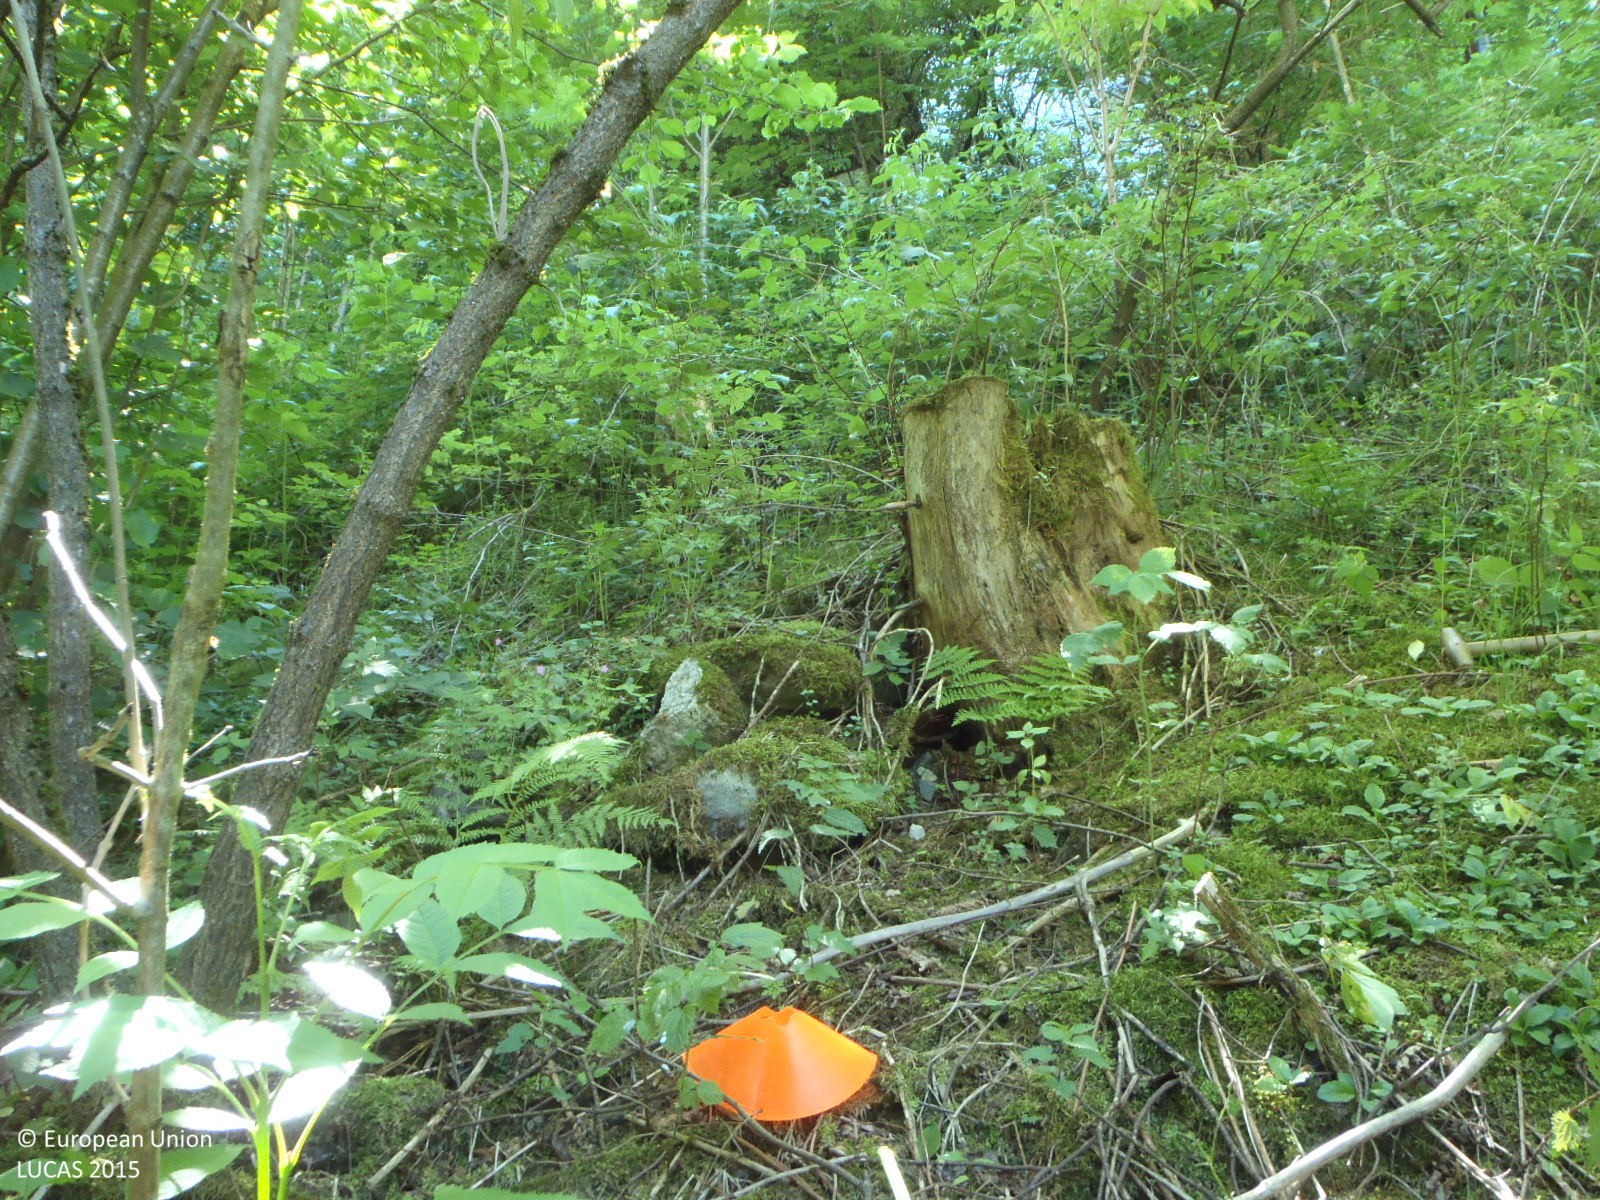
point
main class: Woodland
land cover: Broadleaved woodland
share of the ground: > 75 %
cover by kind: broadleaved forest trees 80 %, coniferous forest trees 10 %, herbaceous plants 5 %, lichens and mosses 5 %
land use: Forestry
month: July
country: AT
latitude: 47.3867
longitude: 12.4224
